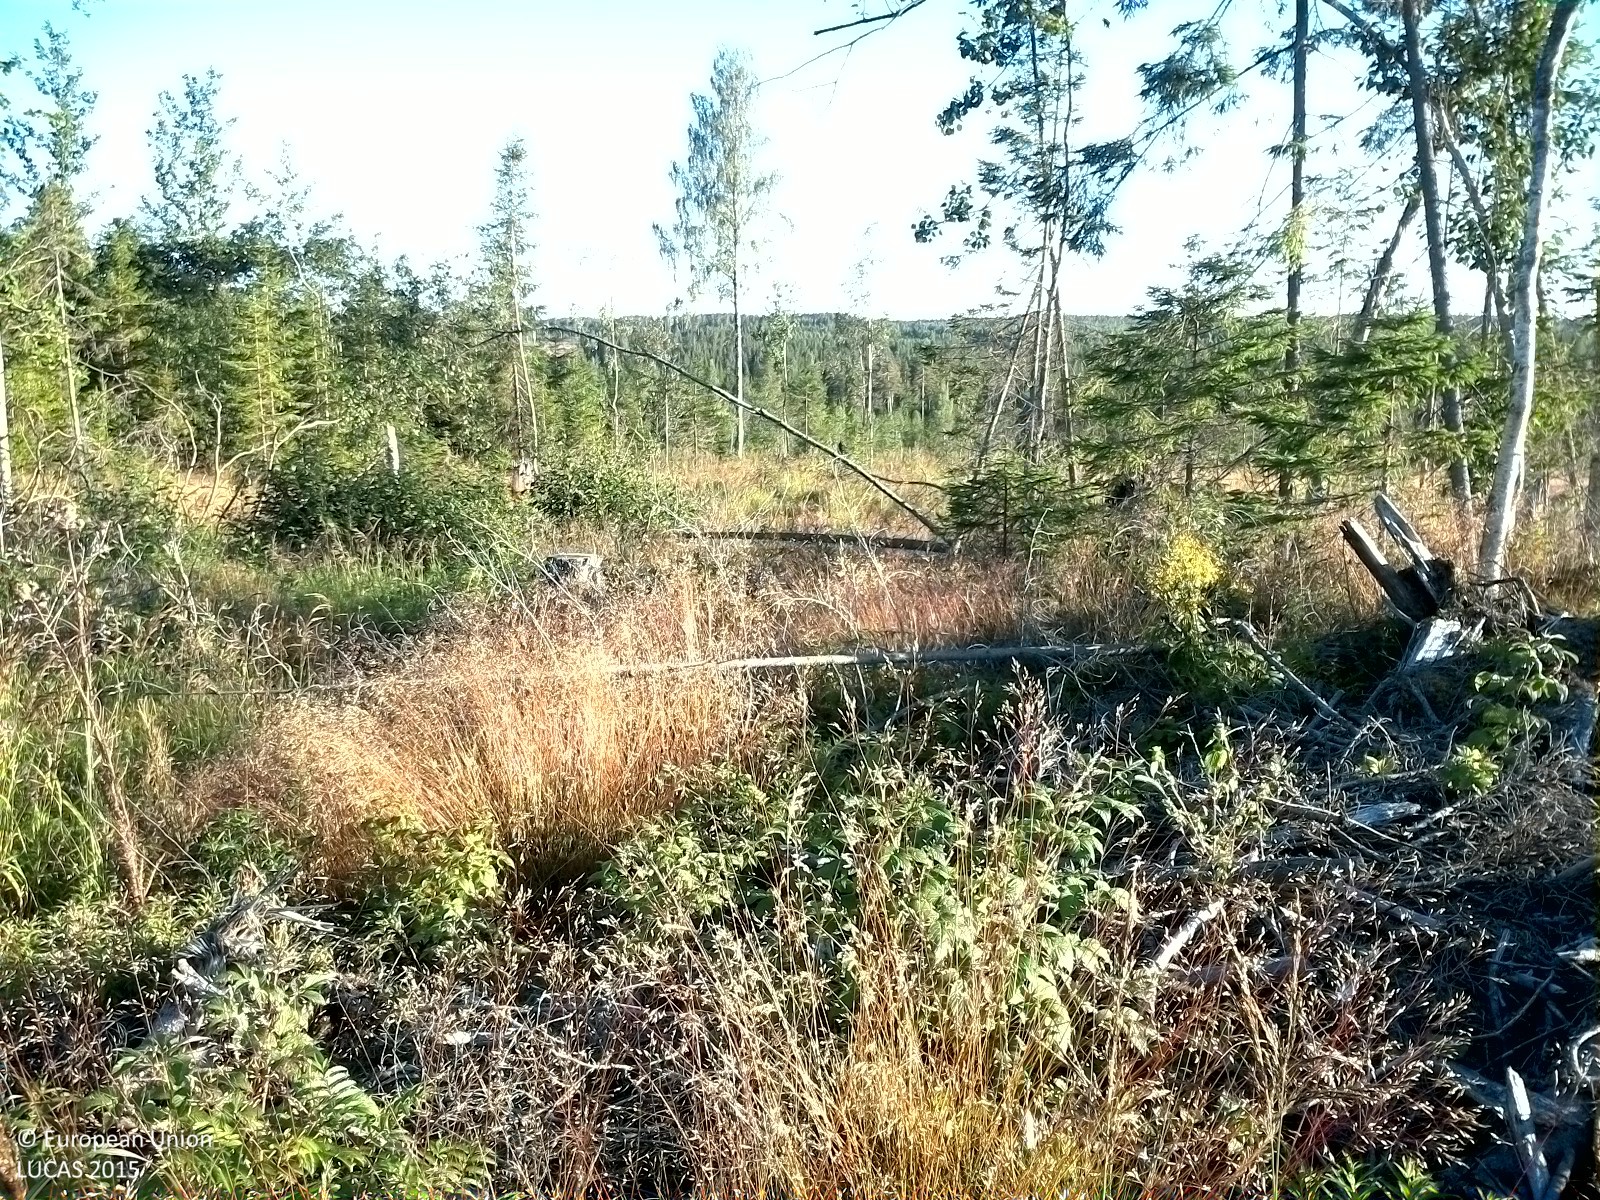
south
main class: Grassland
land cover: Grassland with sparse tree/shrub cover
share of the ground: > 75 %
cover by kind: herbaceous plants 90 %, broadleaved forest trees 5 %, unconsolidated bare surface 5 %
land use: Forestry
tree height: < 5 m
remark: Clear cut
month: August
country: SE
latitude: 62.3654
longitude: 16.4539
